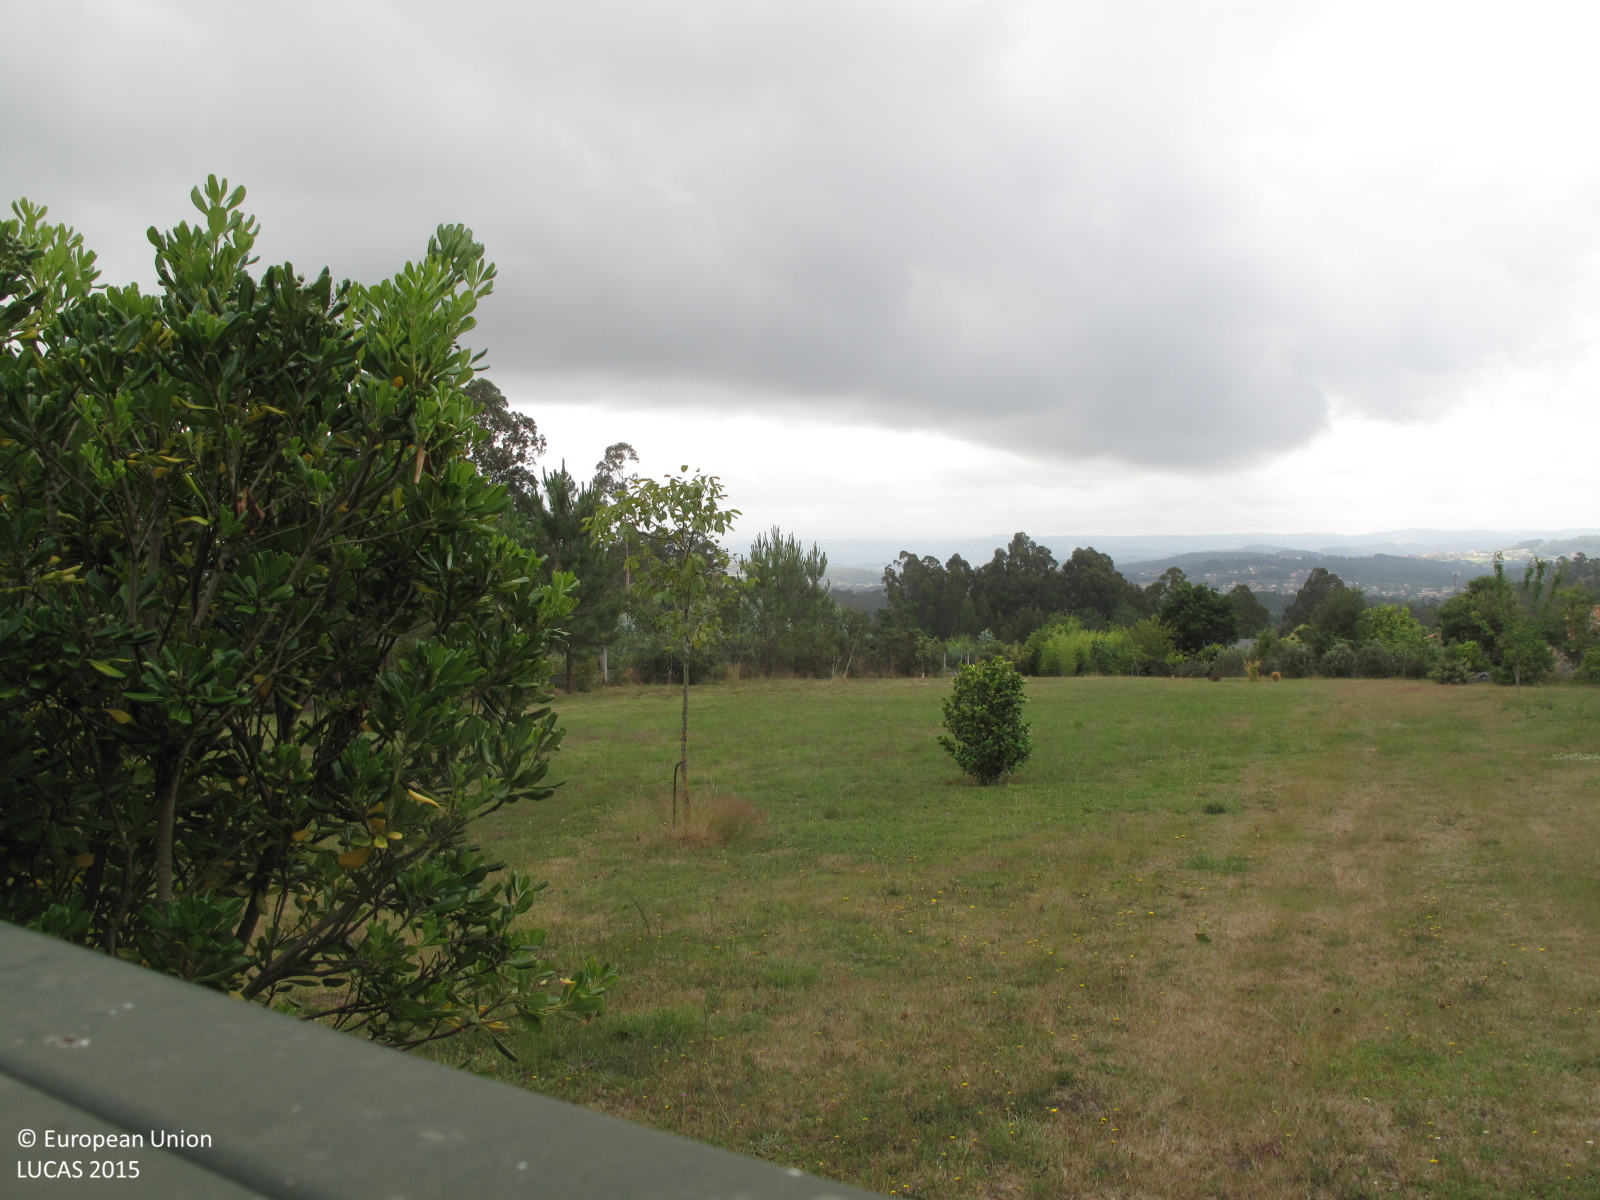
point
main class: Grassland
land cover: Grassland with sparse tree/shrub cover
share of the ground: > 75 %
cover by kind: herbaceous plants 95 %, broadleaved forest trees 5 %
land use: Residential
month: July
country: ES
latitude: 43.2996
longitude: -8.2842
